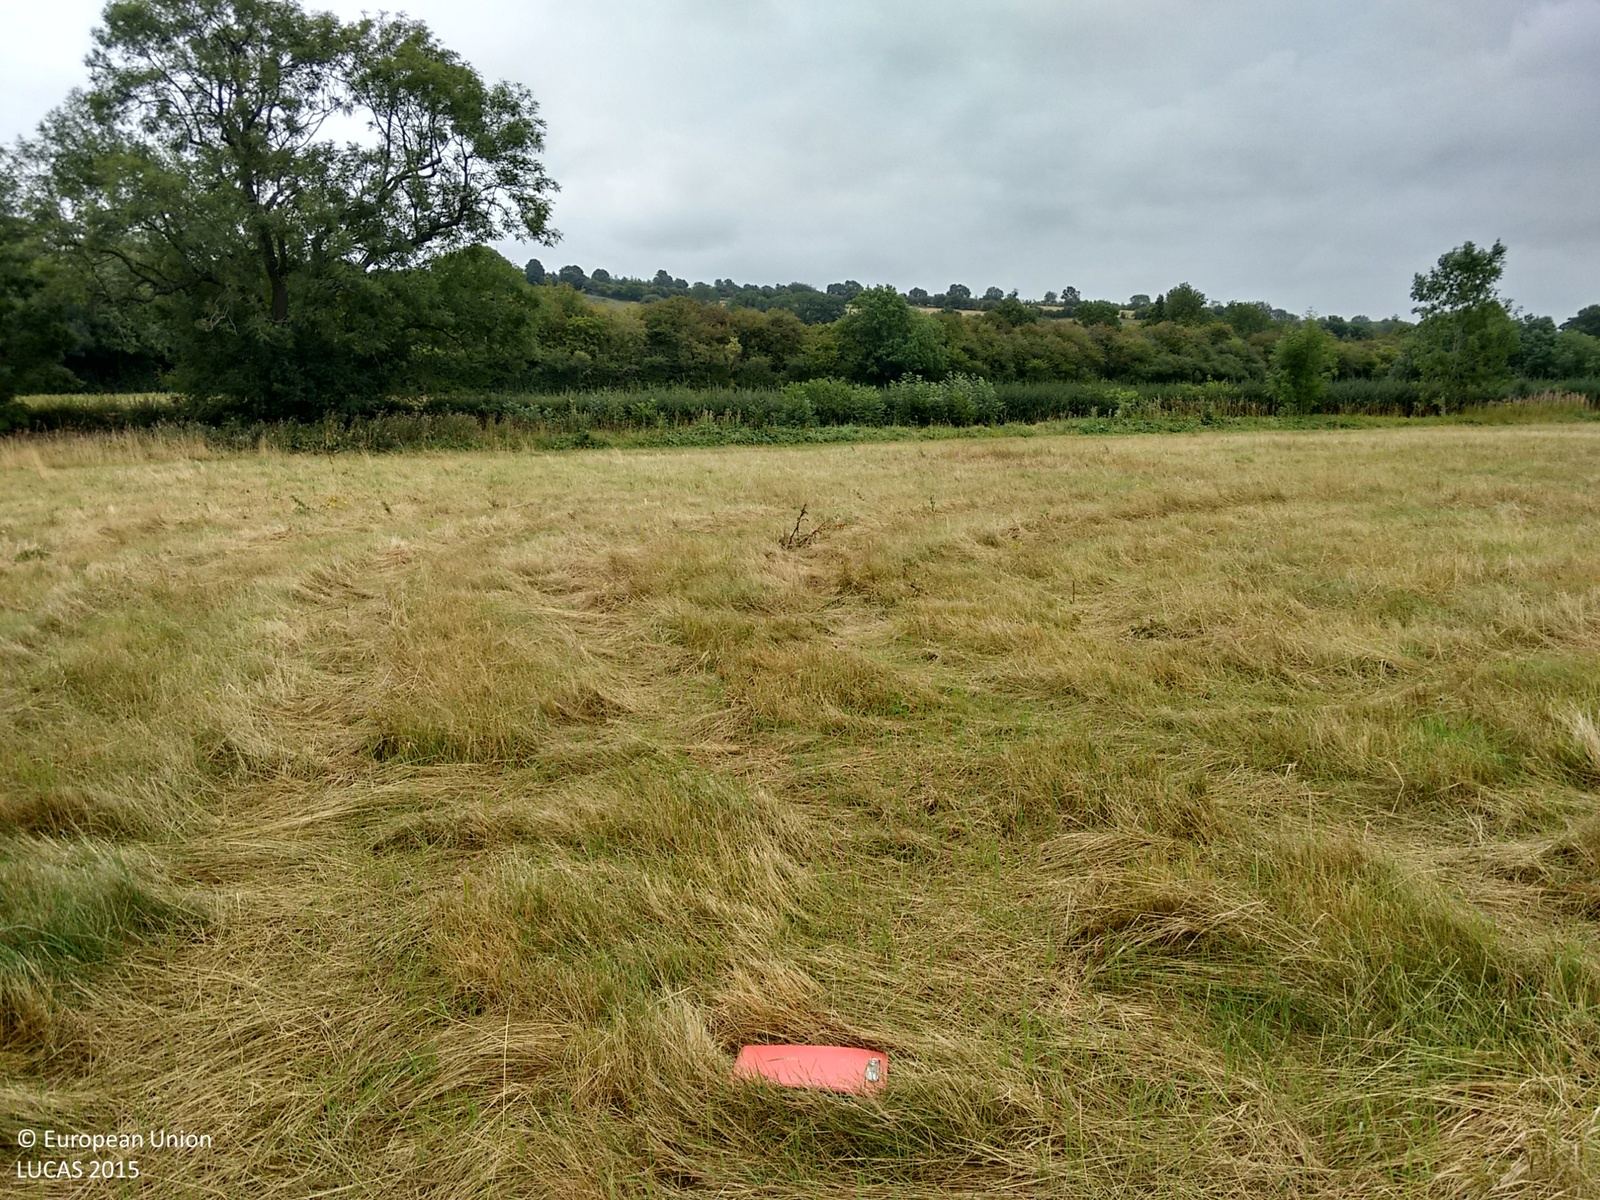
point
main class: Grassland
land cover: Grassland without tree/shrub cover
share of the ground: > 75 %
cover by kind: herbaceous plants 100 %
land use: Agriculture (excluding fallow land and kitchen gardens)
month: August
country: GB
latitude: 52.1543
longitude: -1.1991
